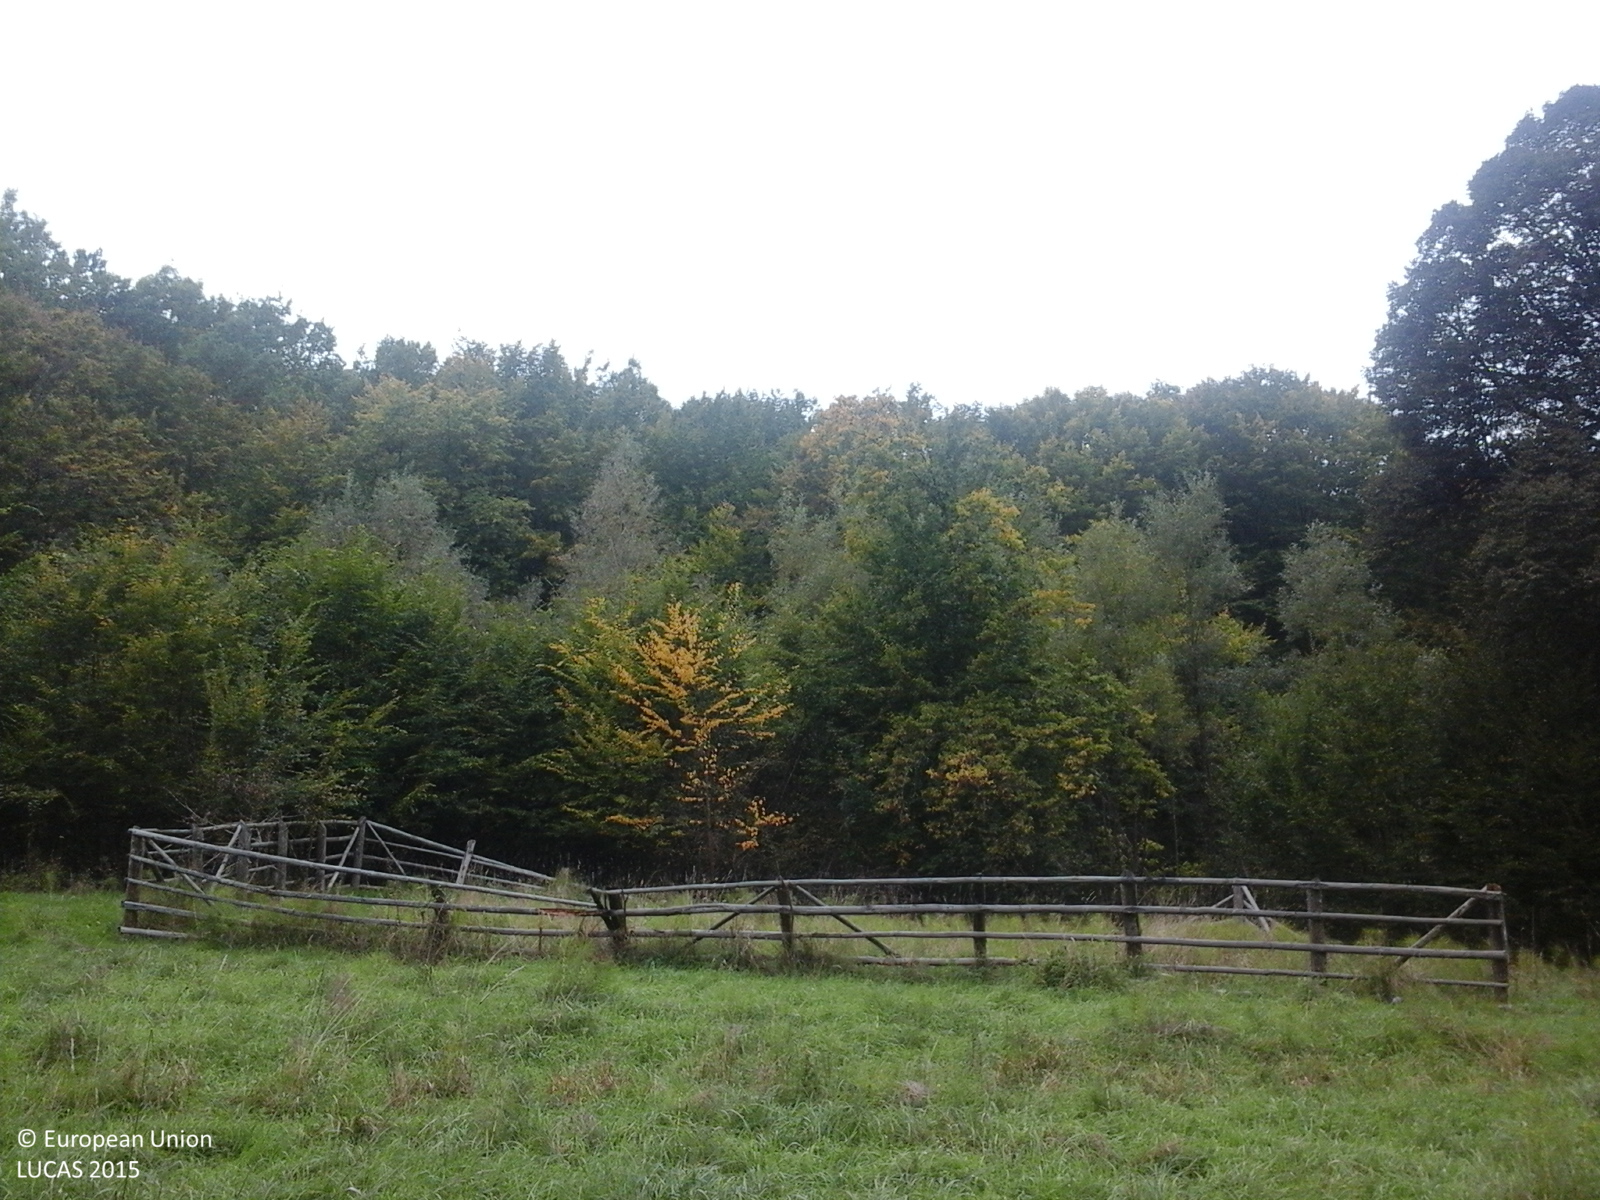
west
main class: Grassland
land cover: Grassland without tree/shrub cover
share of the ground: > 75 %
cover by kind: herbaceous plants 100 %
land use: Semi-natural and natural areas not in use
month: October
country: RO
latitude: 46.8132
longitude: 24.8131
